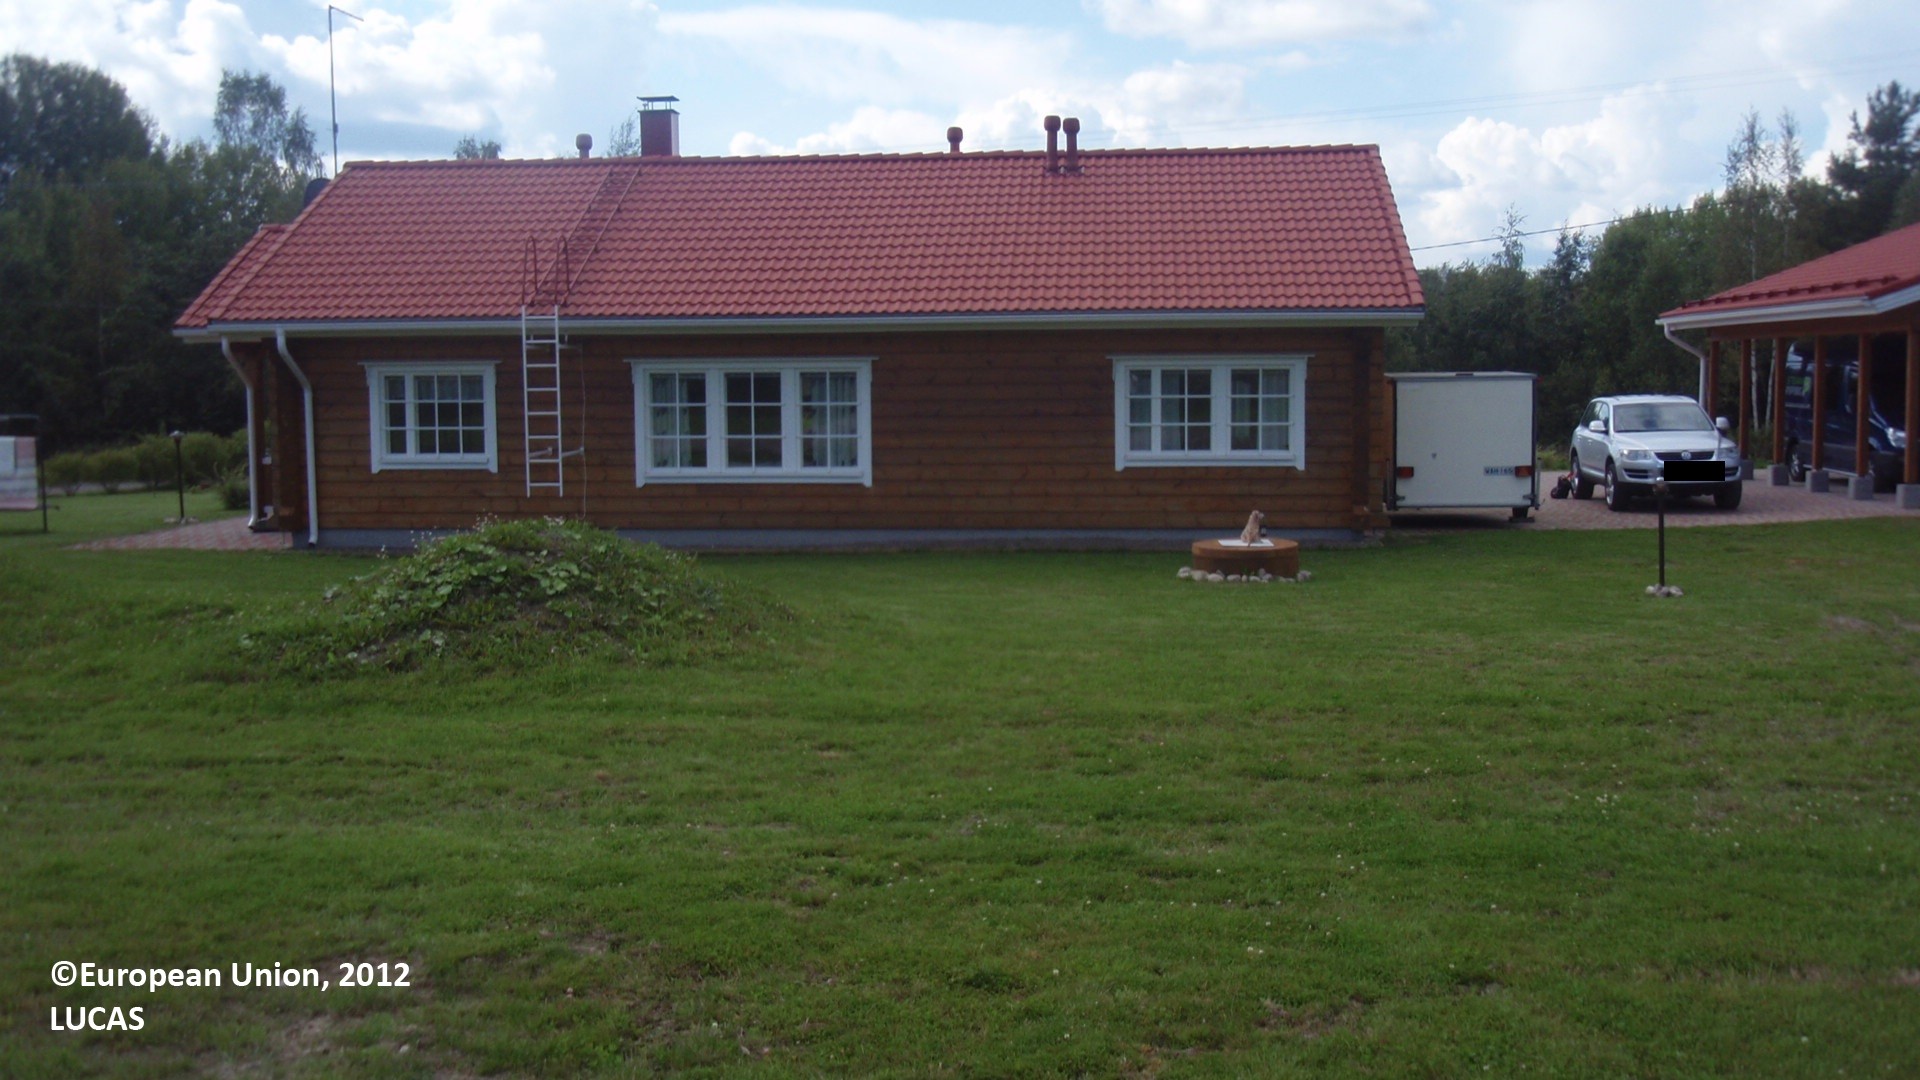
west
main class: Grassland
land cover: Grassland without tree/shrub cover
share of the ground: > 75 %
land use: Residential
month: August
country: FI
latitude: 60.9323
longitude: 26.6716
